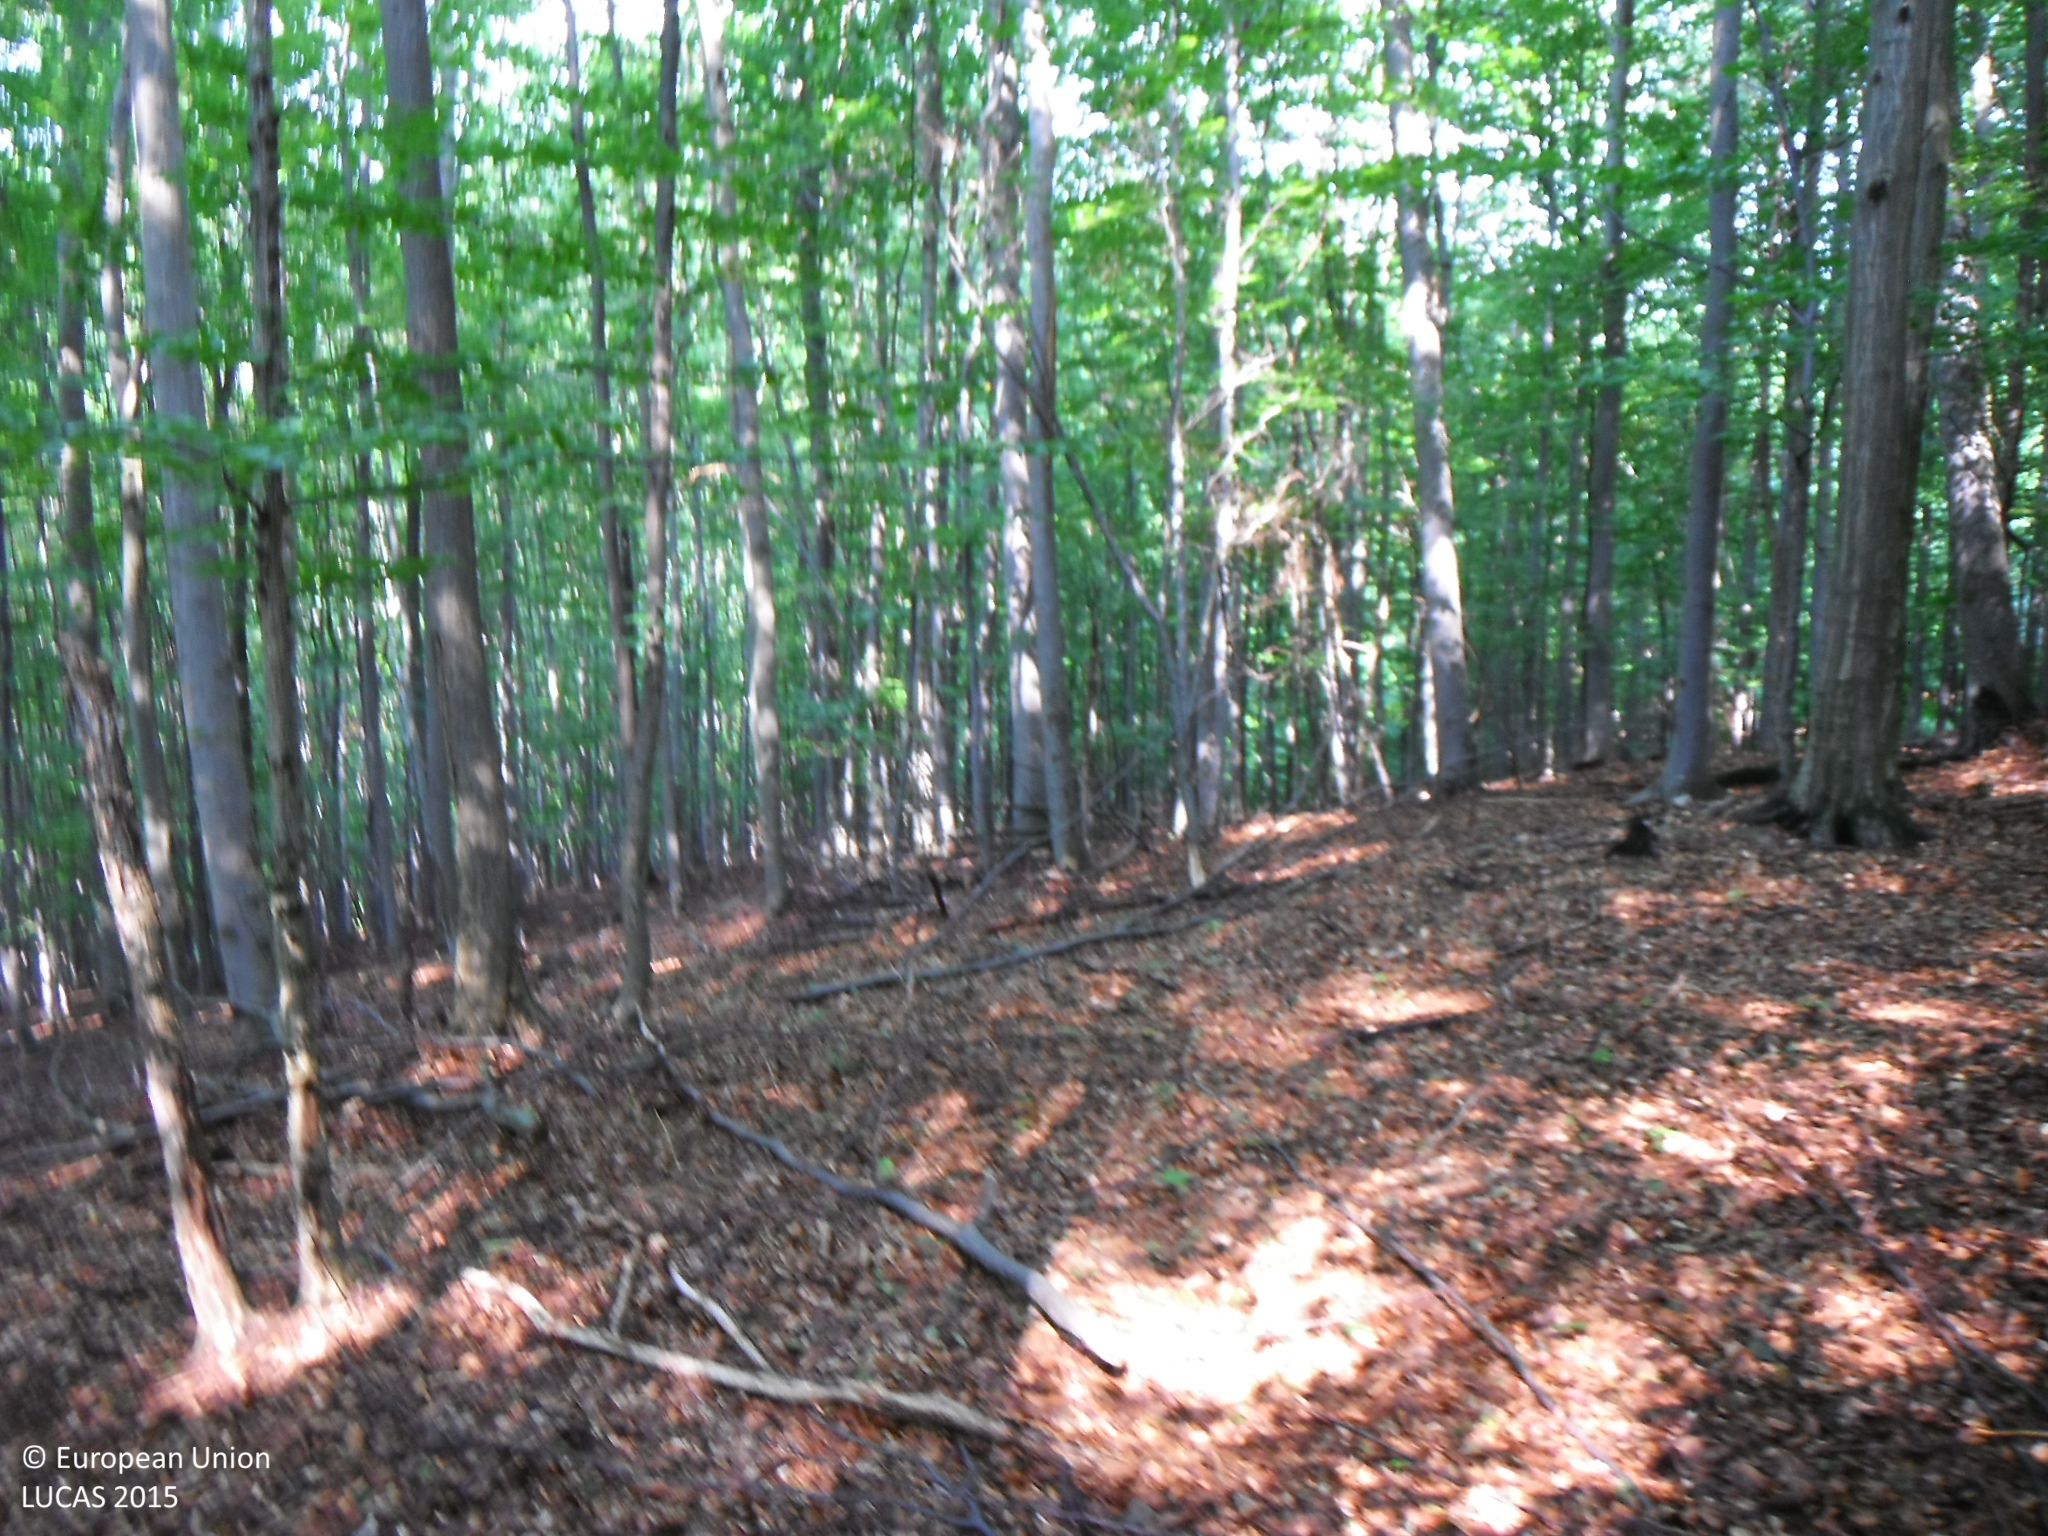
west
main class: Woodland
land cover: Broadleaved woodland
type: beech forest
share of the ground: > 75 %
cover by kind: broadleaved forest trees 95 %, herbaceous plants 5 %
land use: Forestry
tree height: > 5 m
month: July
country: SK
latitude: 49.3870
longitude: 21.2738
